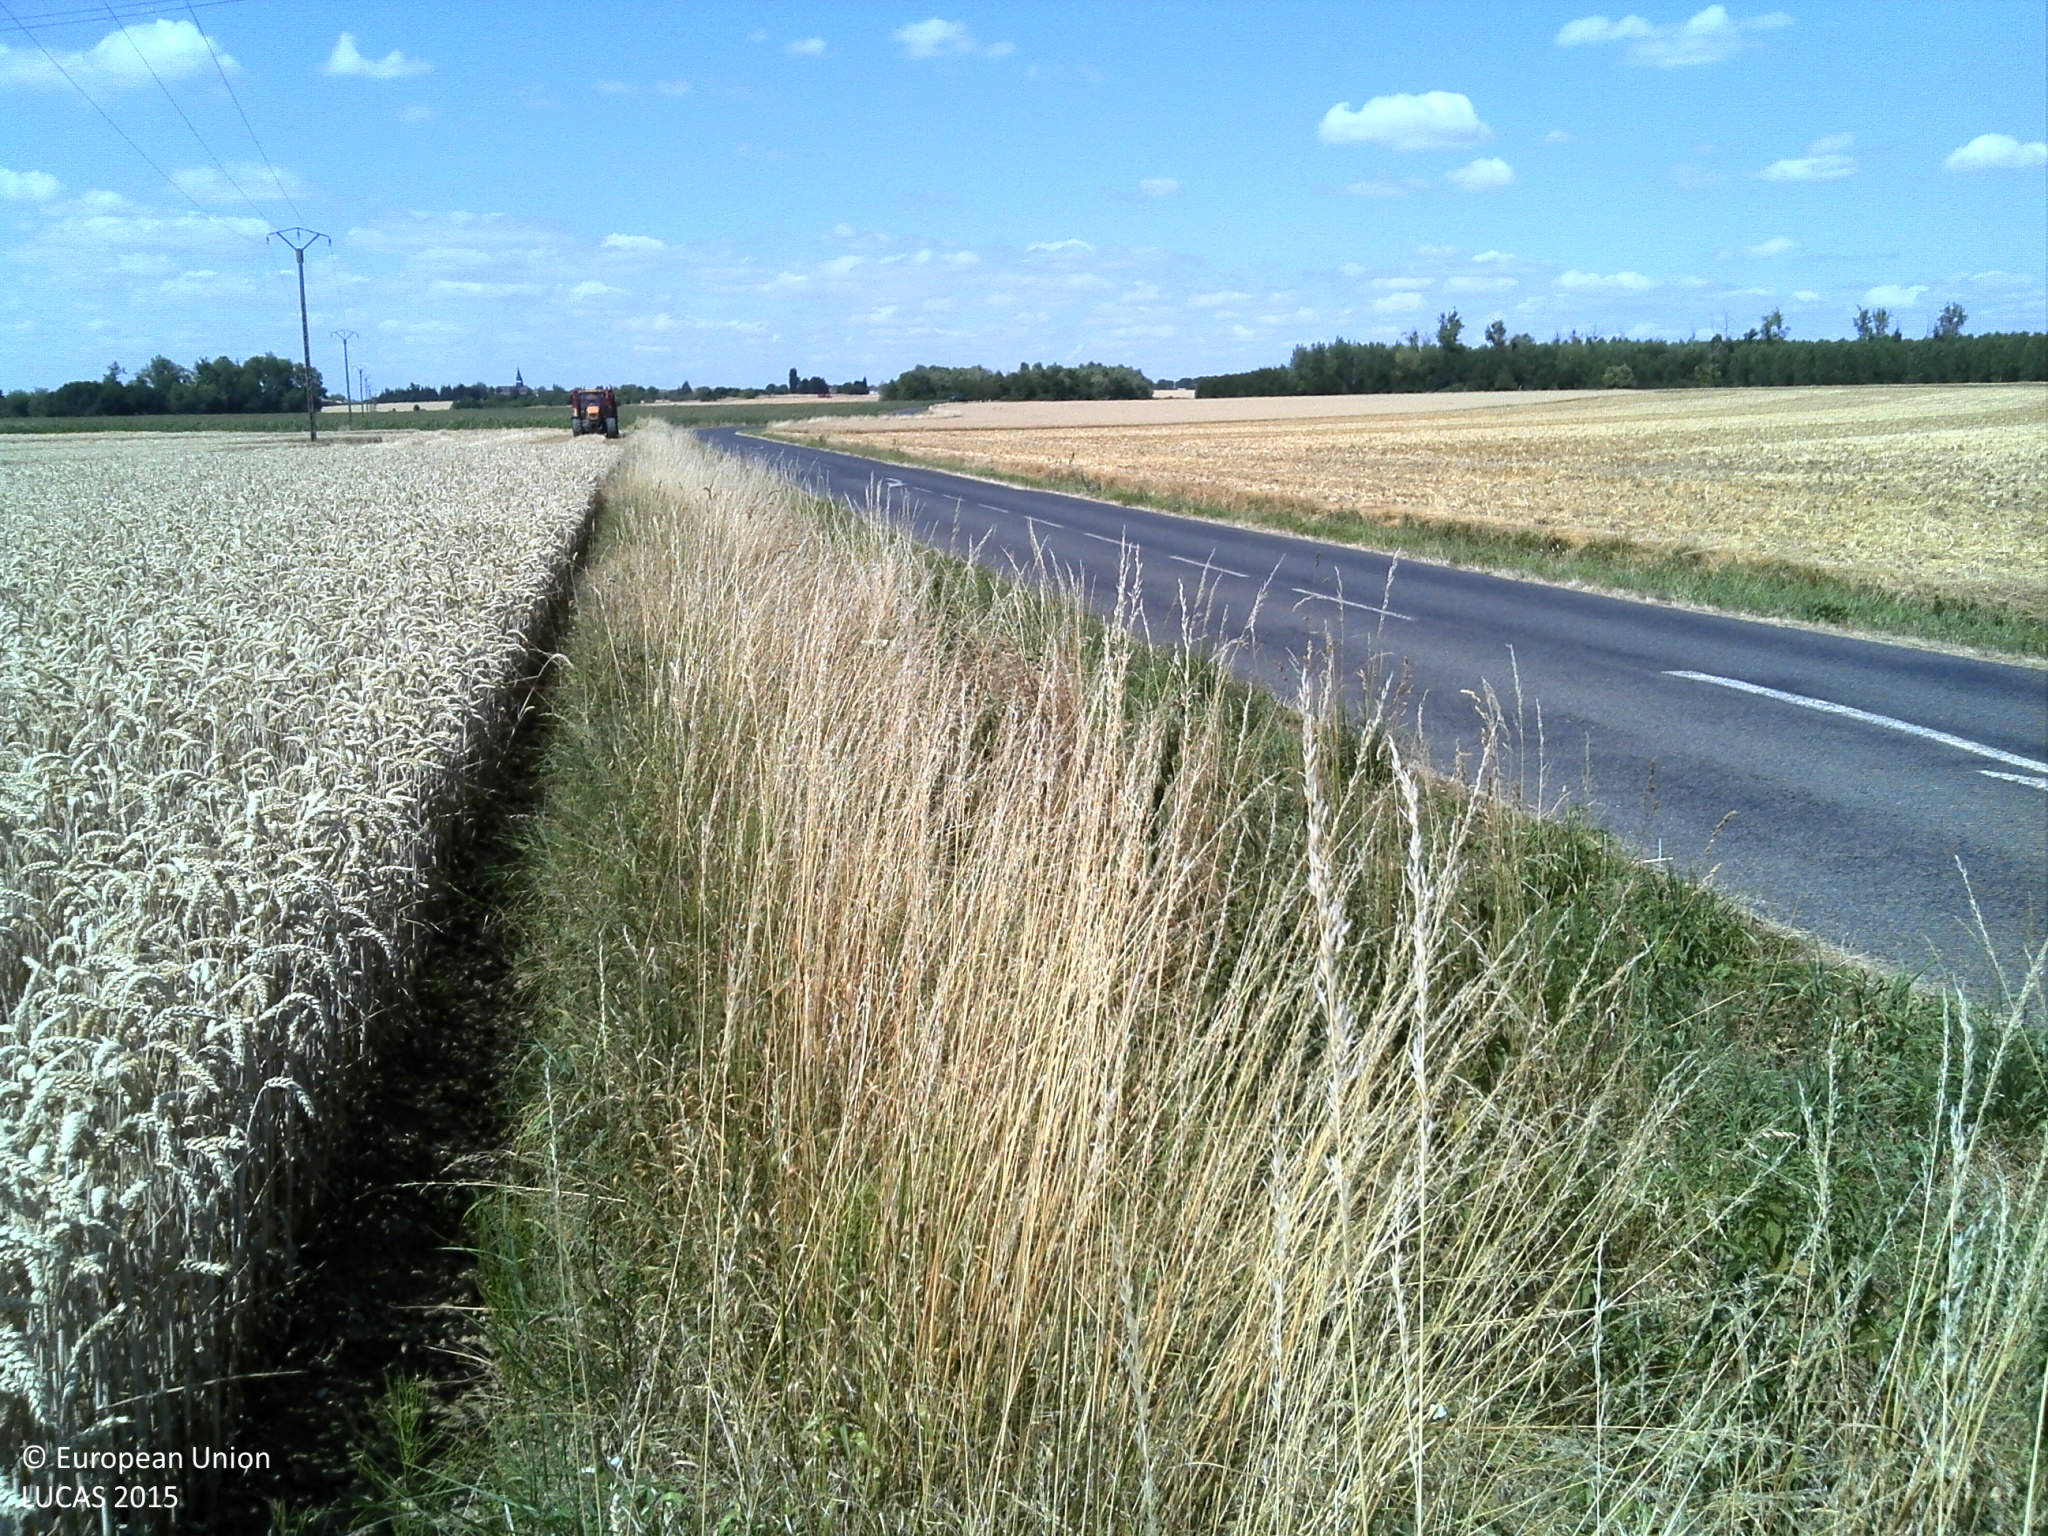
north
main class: Cropland
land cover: Common wheat
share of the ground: > 75 %
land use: Agriculture (excluding fallow land and kitchen gardens)
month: July
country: FR
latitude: 48.6225
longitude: 4.7747
